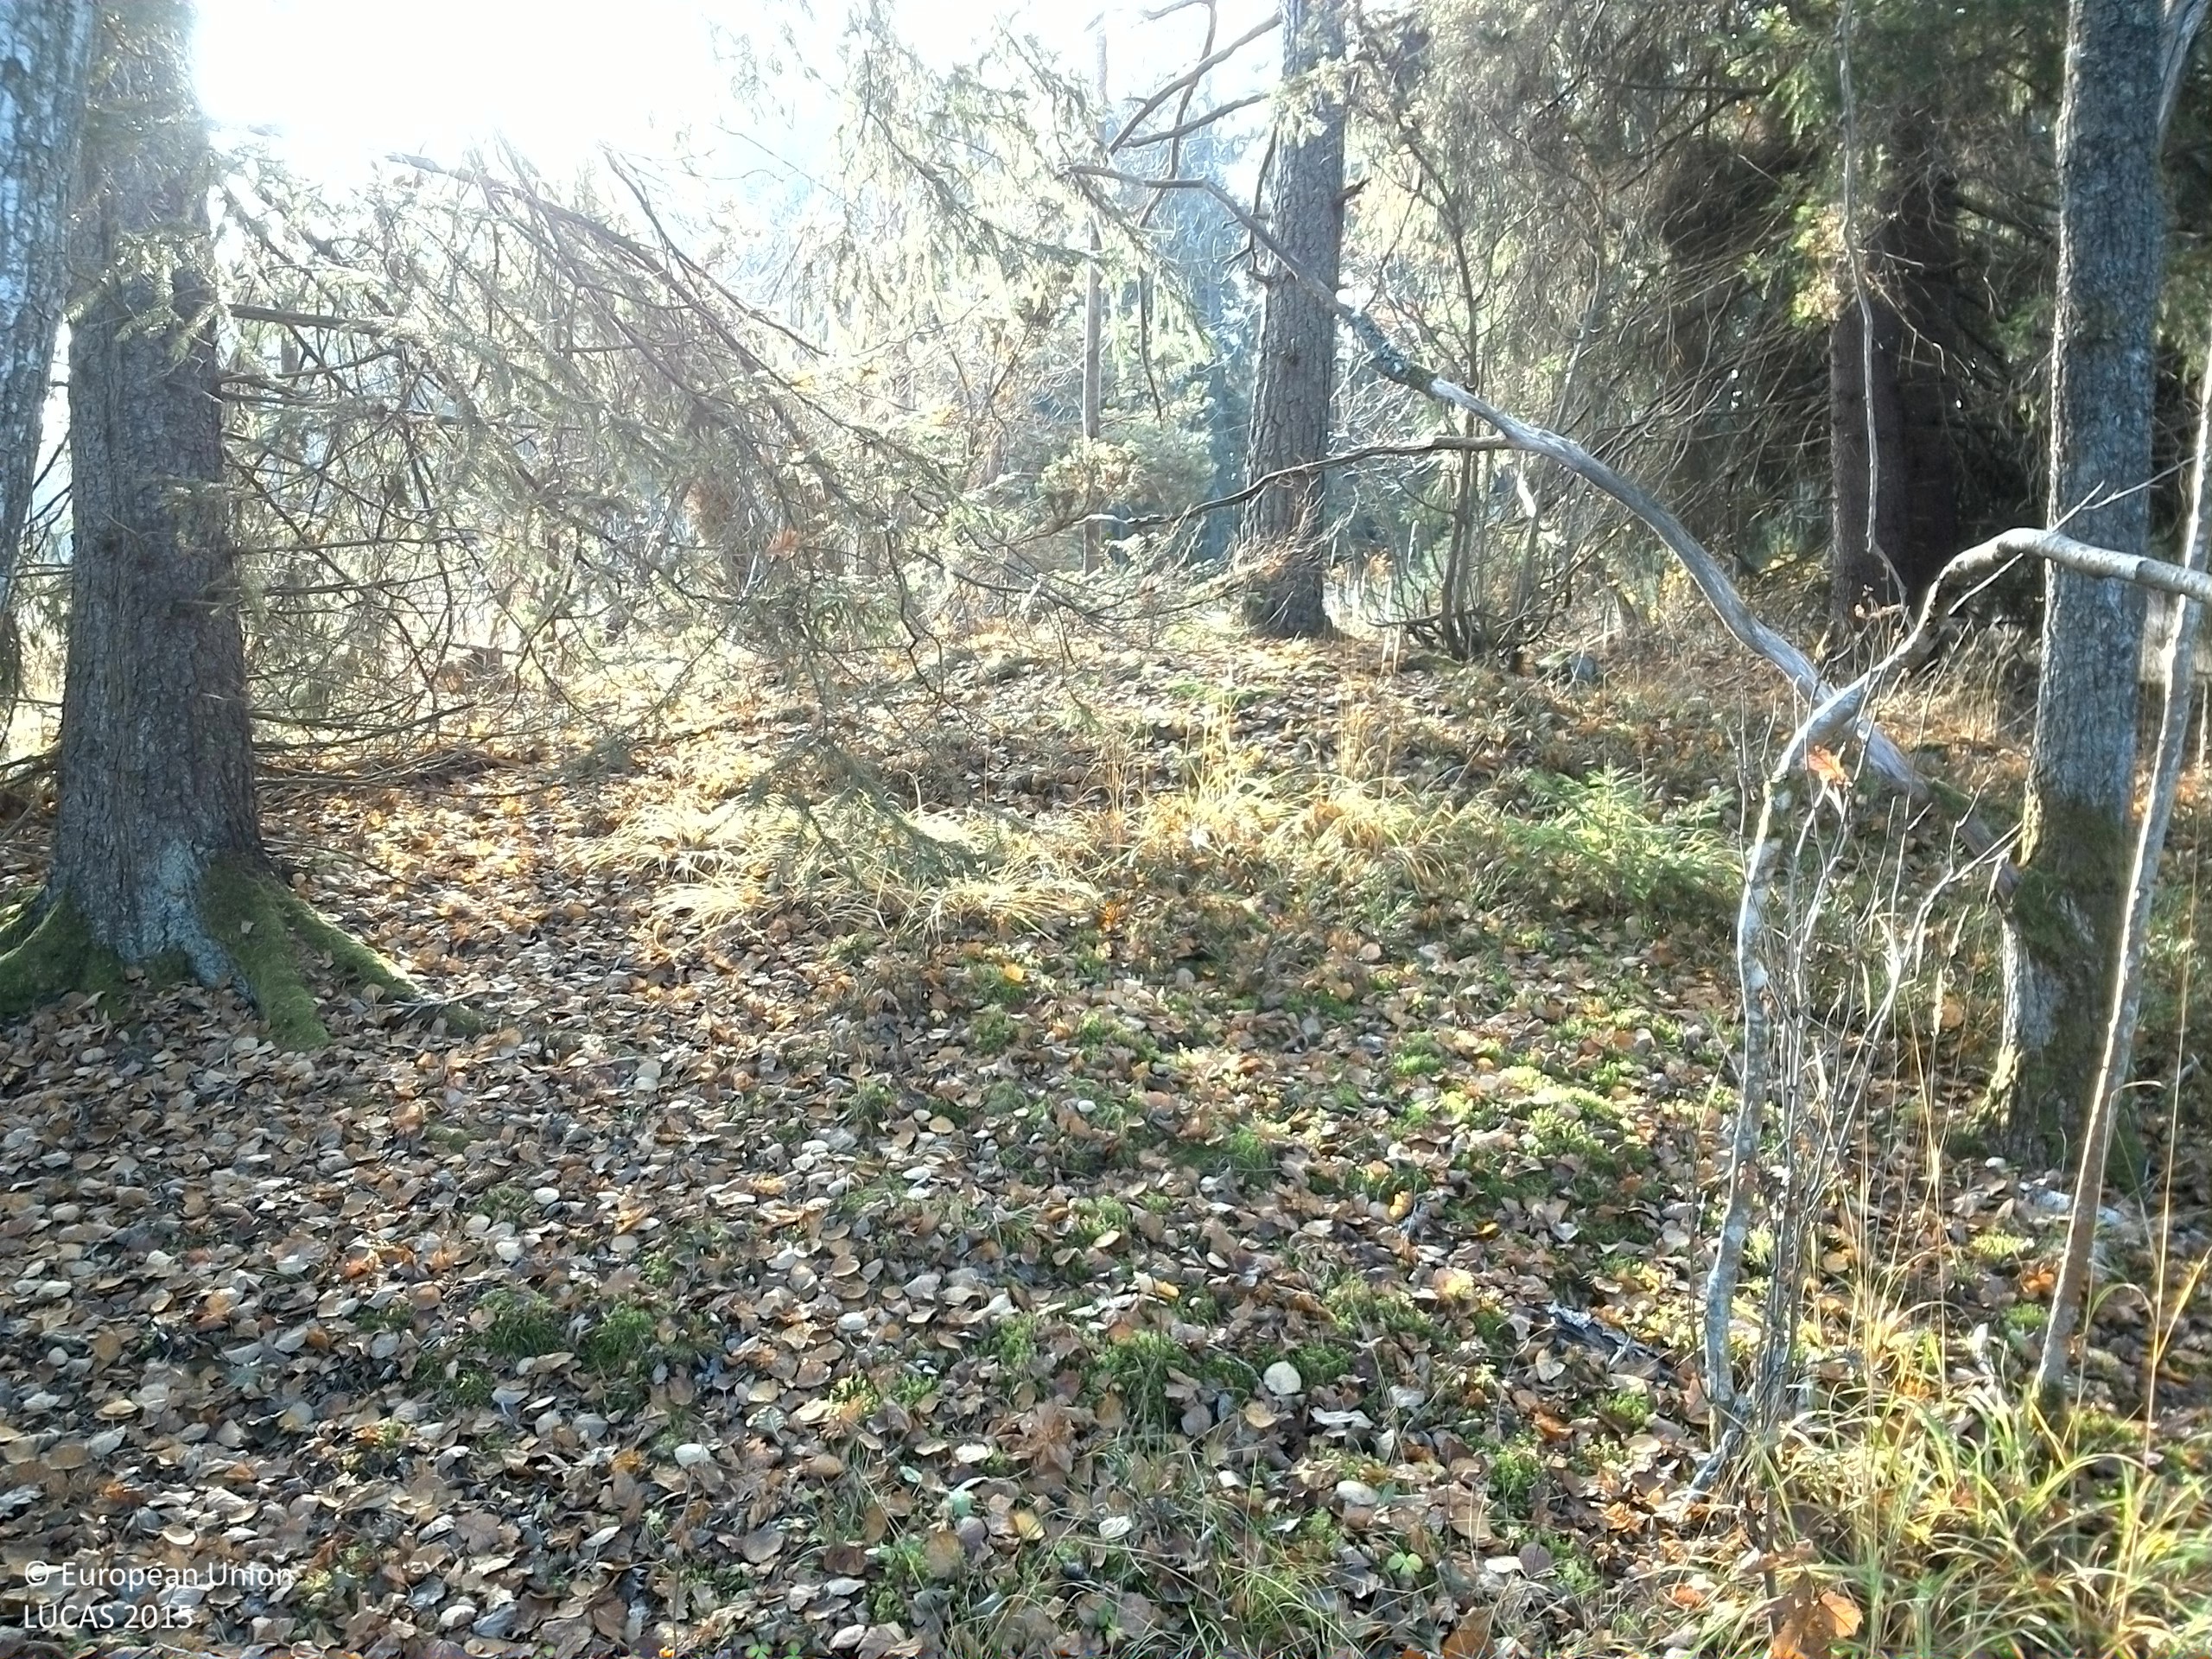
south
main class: Woodland
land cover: Broadleaved woodland
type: hemiboreal forest and nemoral coniferous forest and mixed broadleaved-coniferous forest
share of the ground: > 75 %
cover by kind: broadleaved forest trees 75 %, herbaceous plants 10 %, lichens and mosses 10 %, coniferous forest trees 5 %
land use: Forestry
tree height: > 5 m
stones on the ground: < 10 %
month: October
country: SE
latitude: 59.4091
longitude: 17.0234
